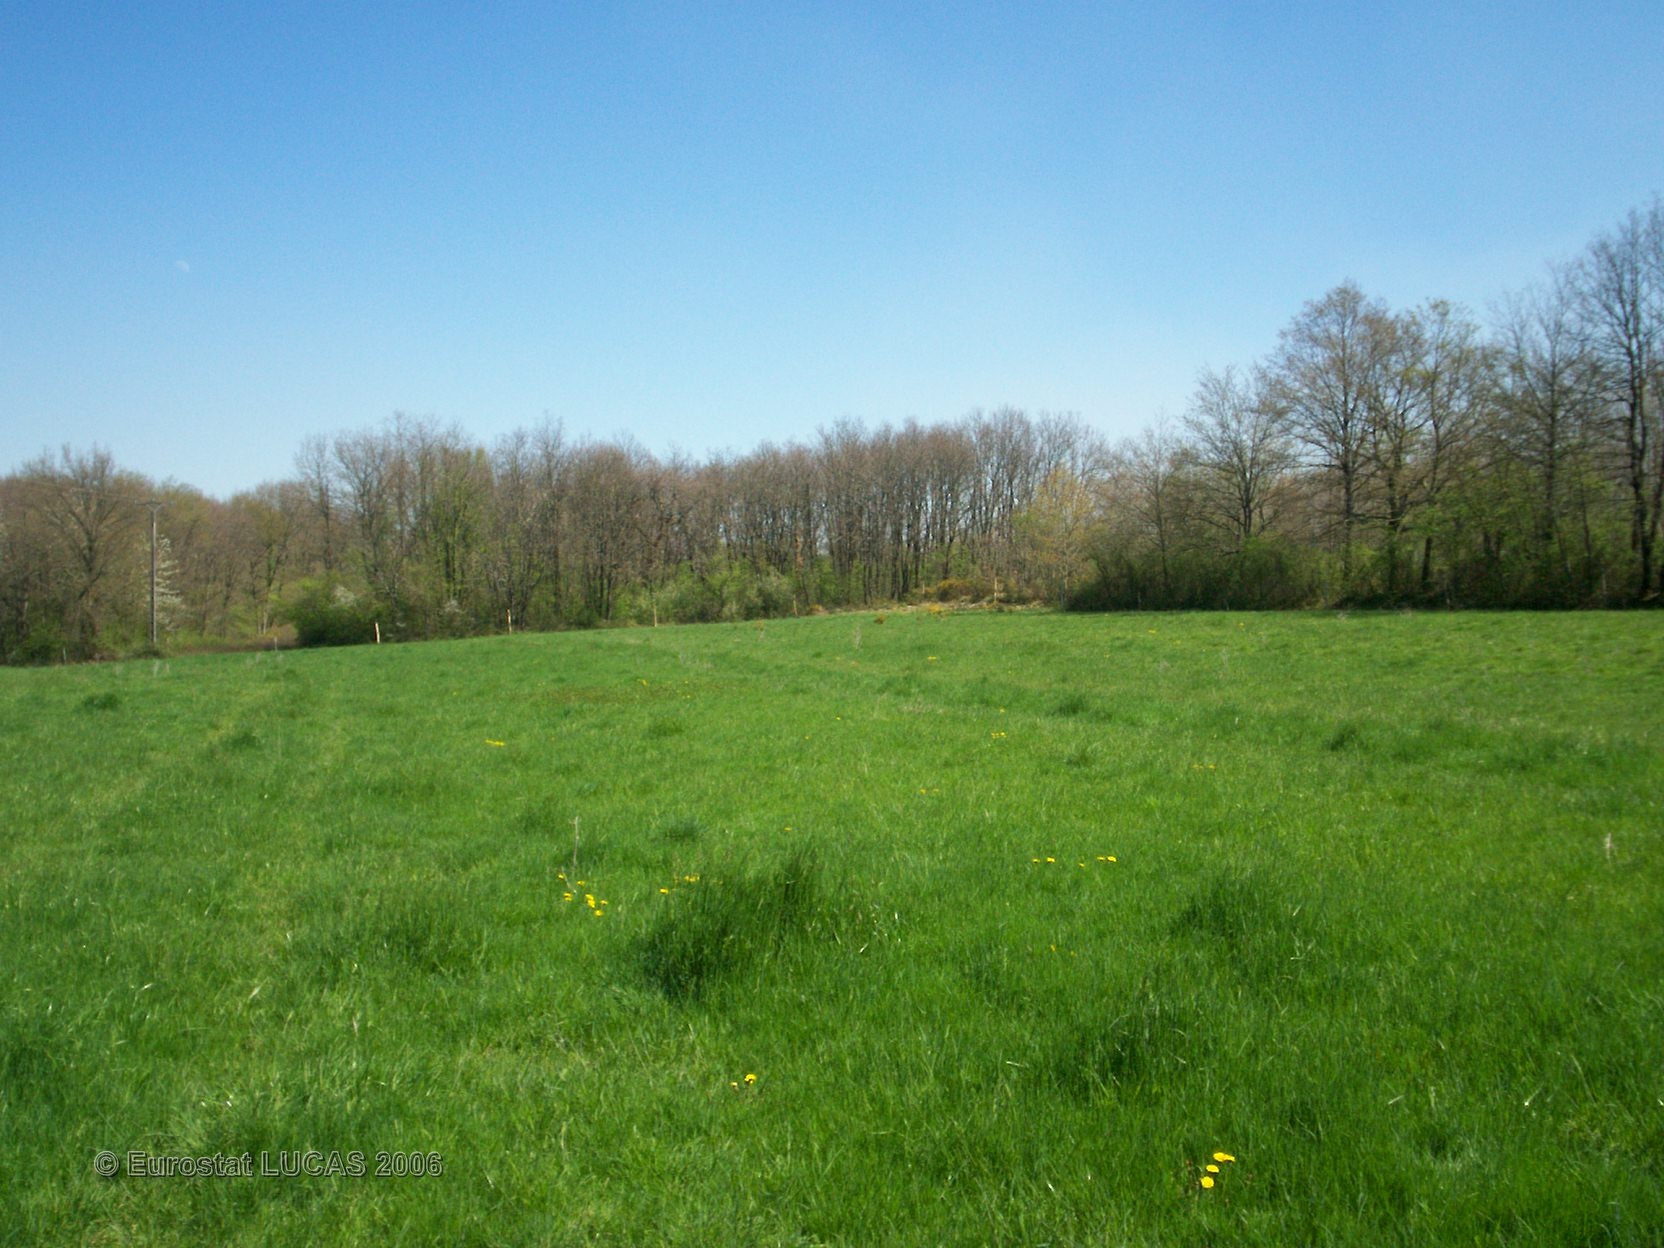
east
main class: Grassland
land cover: Grassland without tree/shrub cover
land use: Agriculture (excluding fallow land and kitchen gardens)
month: April
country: FR
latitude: 44.0228
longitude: 0.9027
